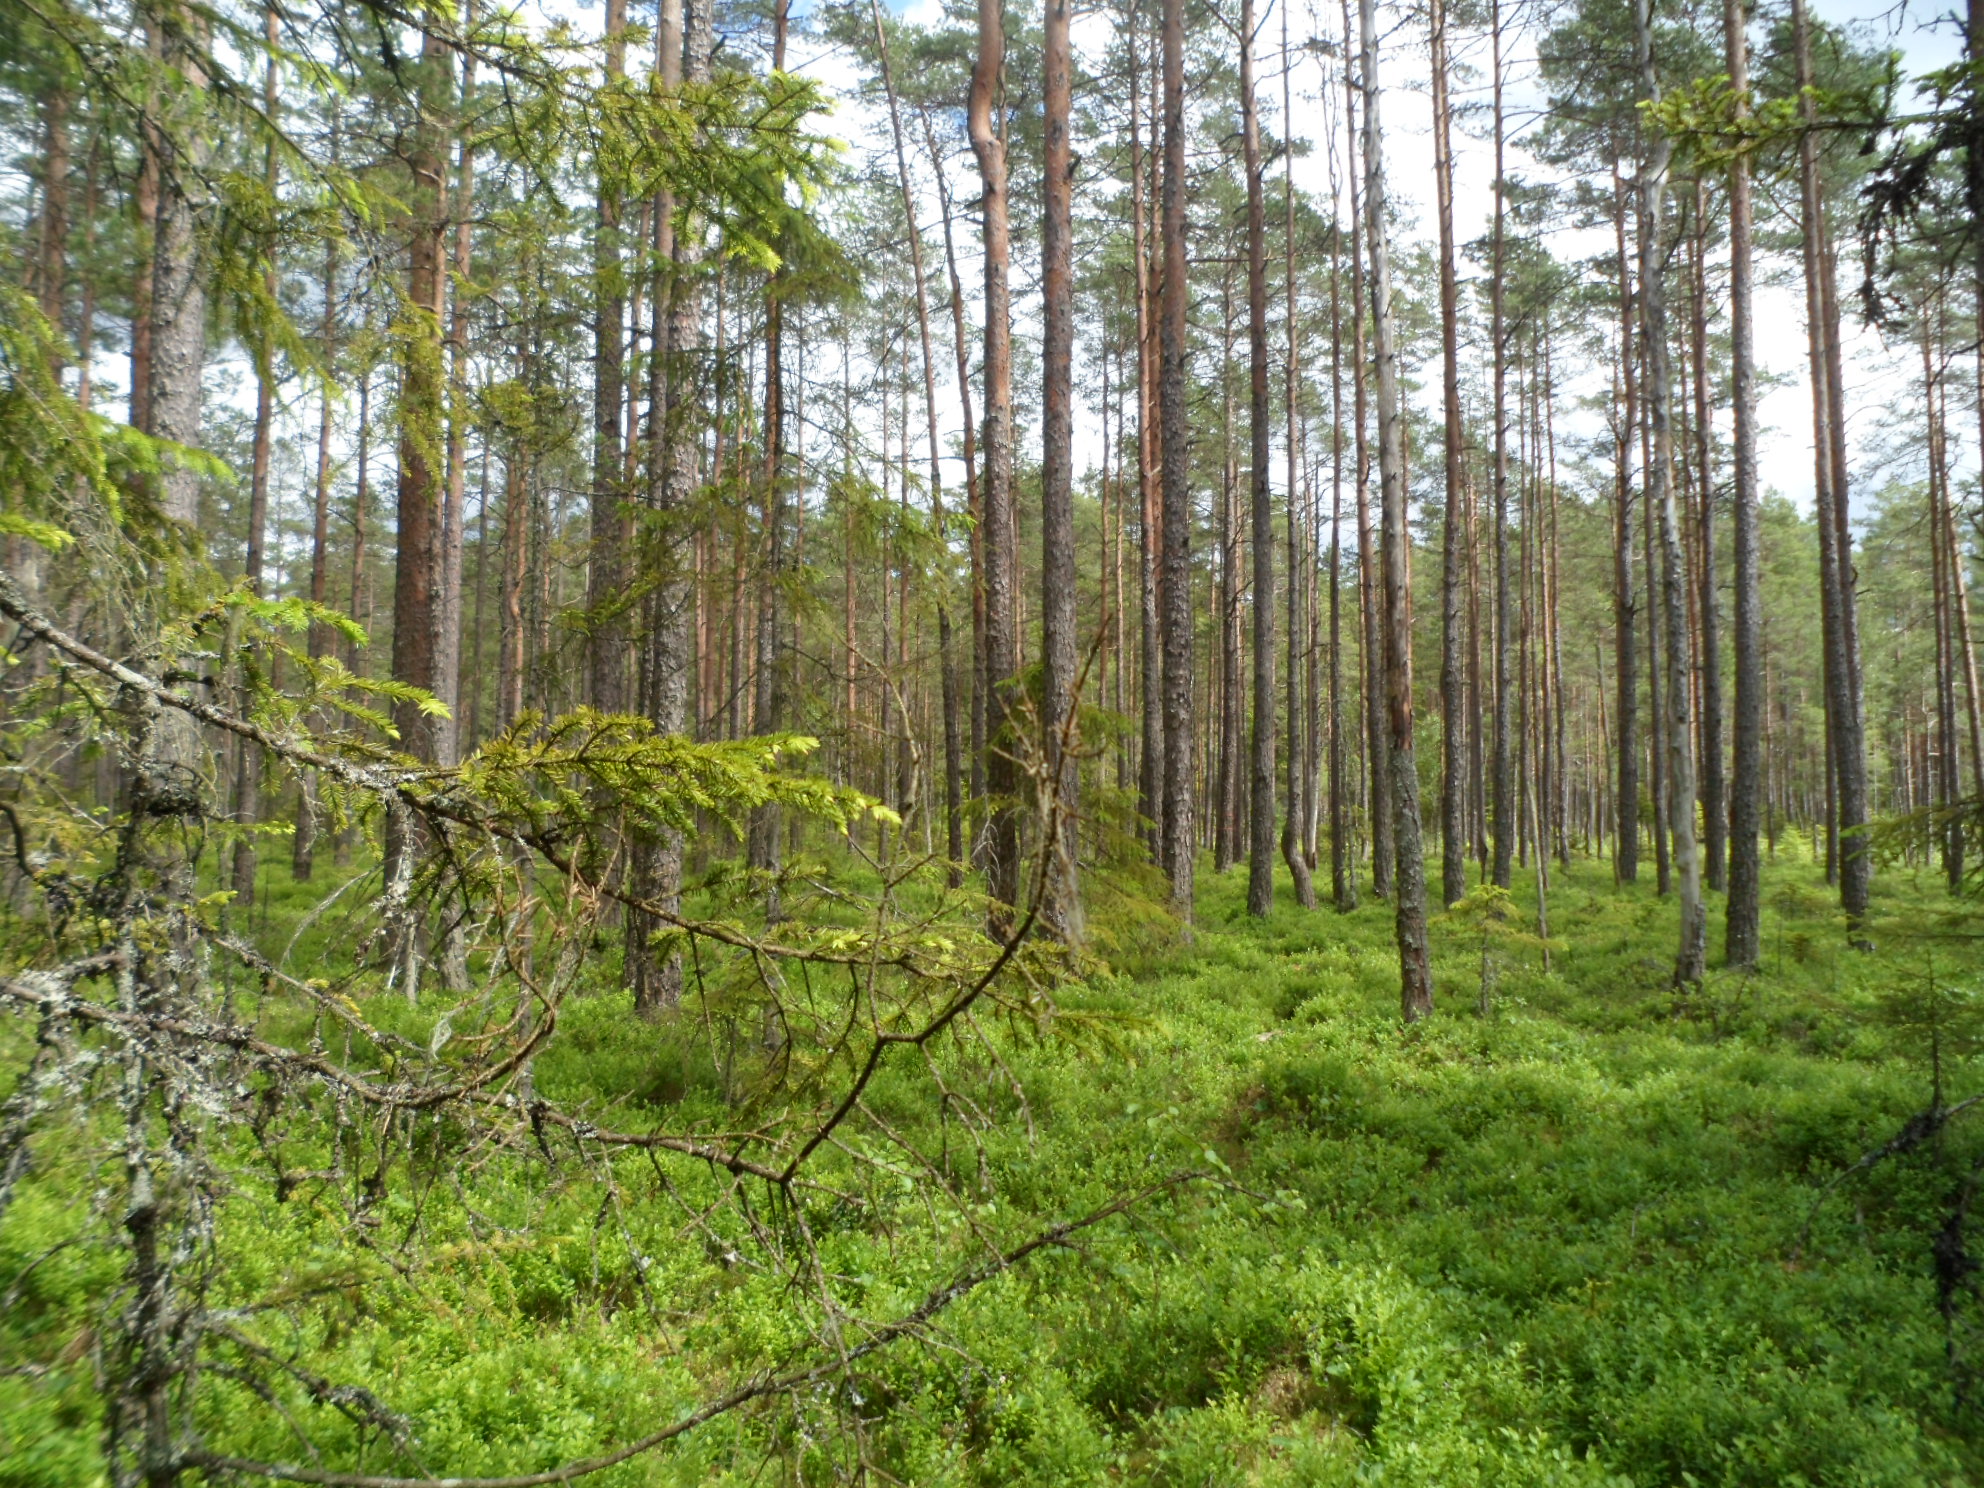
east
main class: Woodland
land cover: Pine dominated coniferous woodland
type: boreal forest
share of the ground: 25 - 50 %
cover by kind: coniferous forest trees 50 %, shrubs 40 %, herbaceous plants 5 %, lichens and mosses 5 %
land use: Forestry
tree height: > 5 m
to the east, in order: Pine dominated coniferous woodland
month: June
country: SE
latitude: 57.1429
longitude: 14.2765
